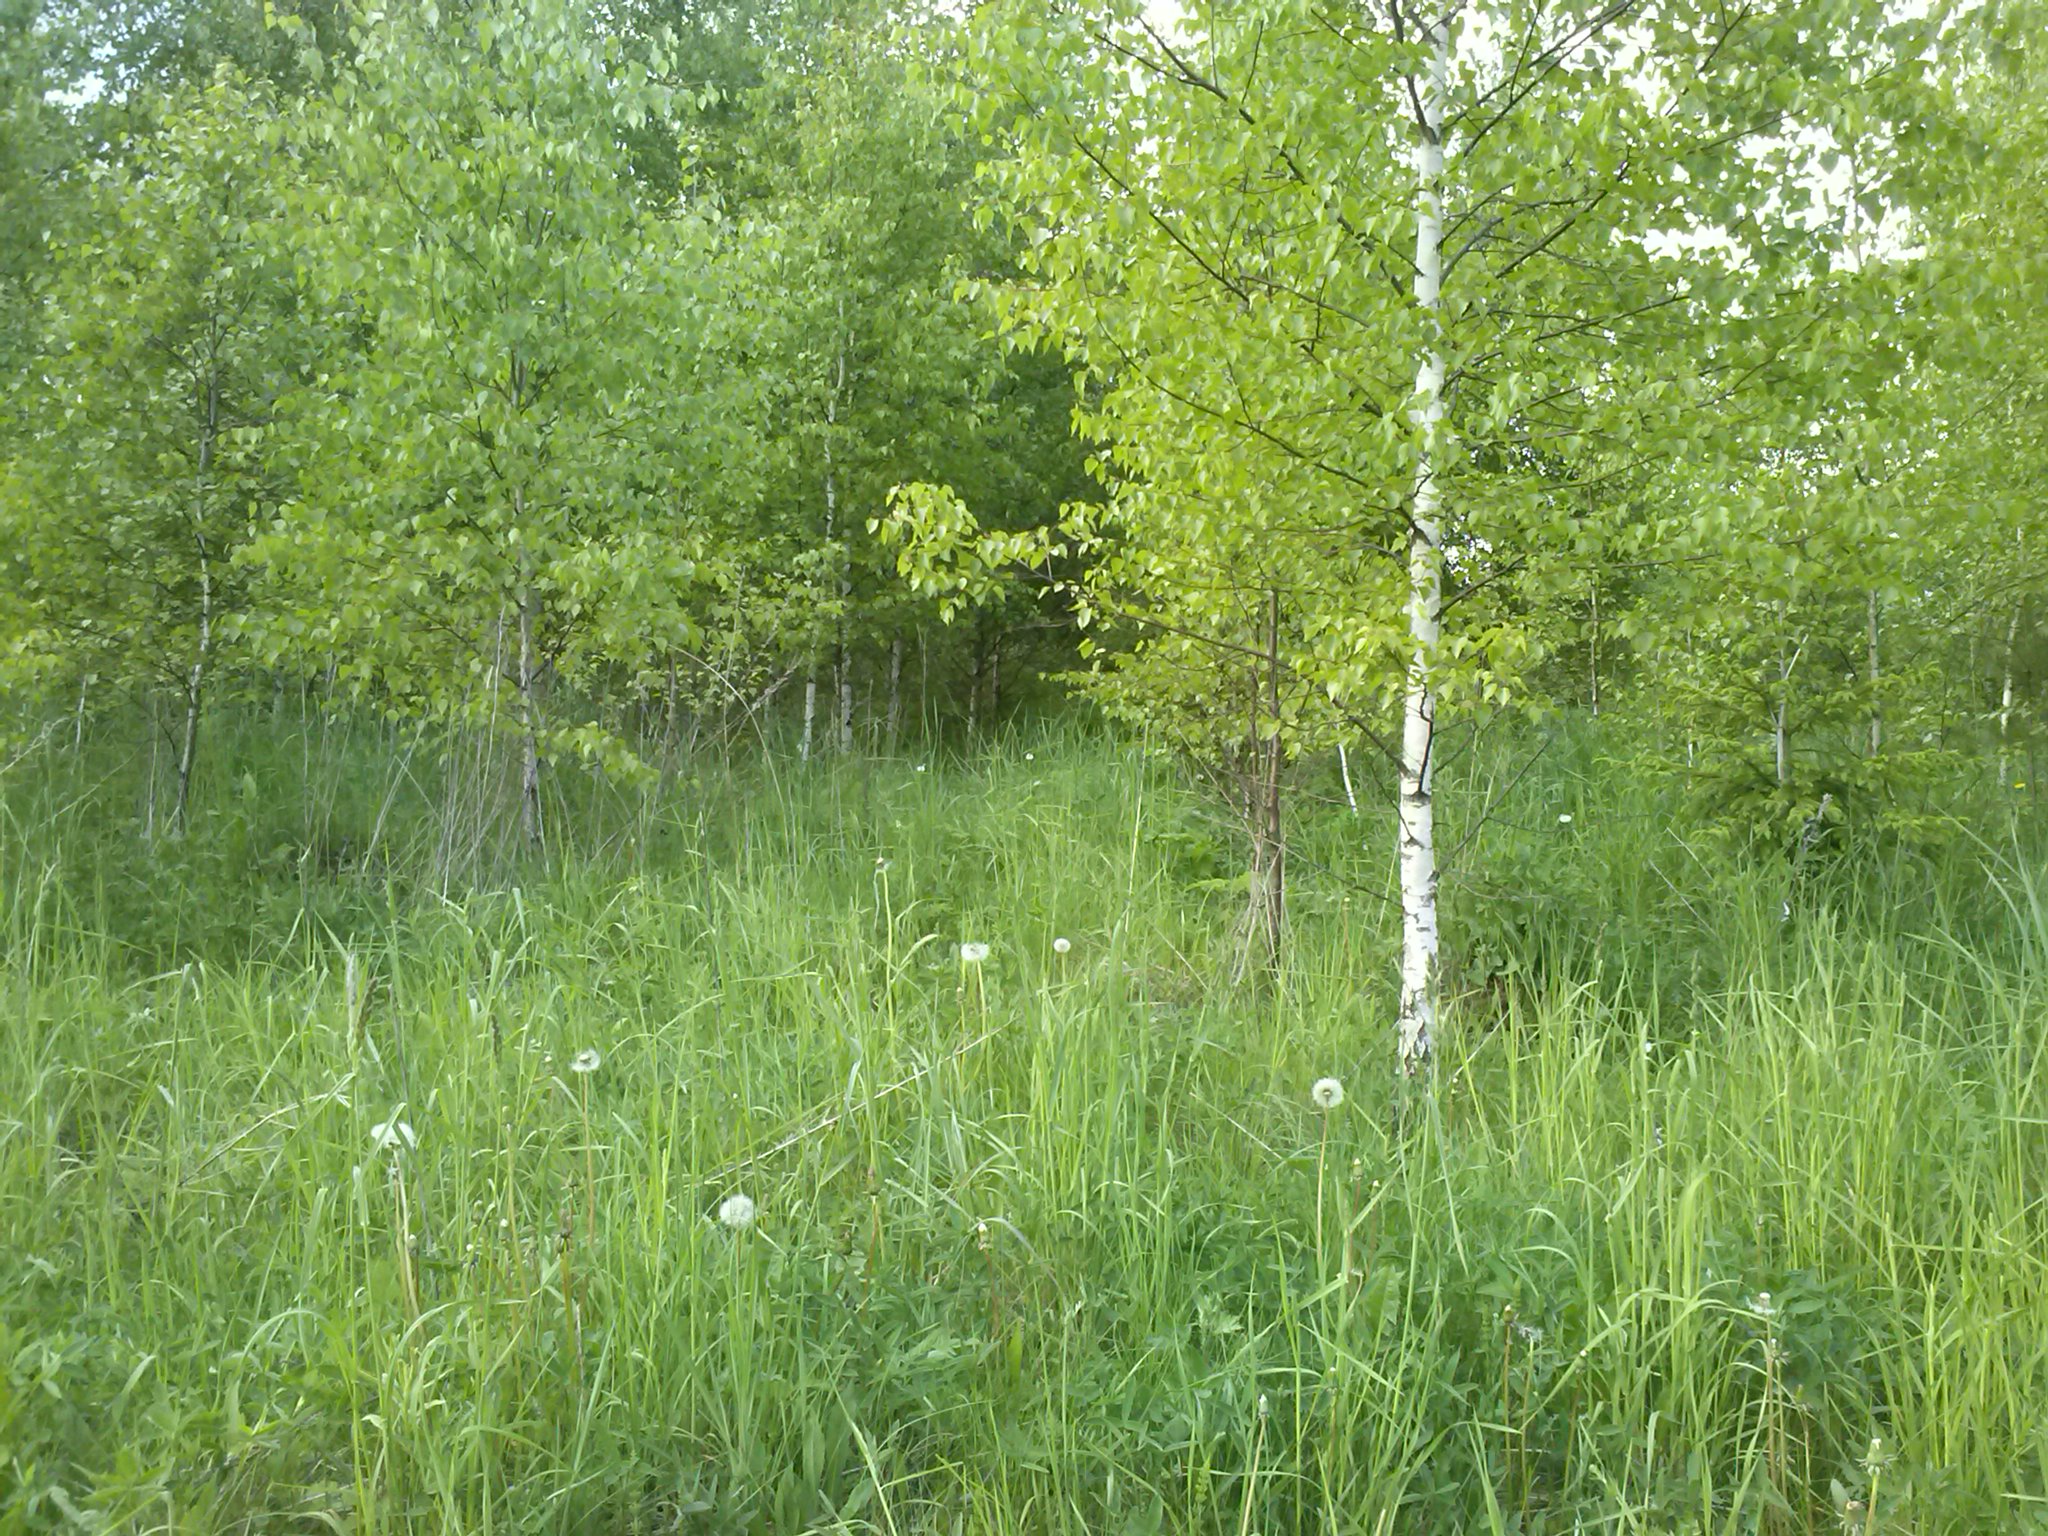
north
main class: Grassland
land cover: Spontaneously vegetated surfaces
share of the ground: > 75 %
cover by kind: herbaceous plants 100 %
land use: Semi-natural and natural areas not in use
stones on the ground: < 10 %
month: May
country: LV
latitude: 56.2963
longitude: 27.7869
